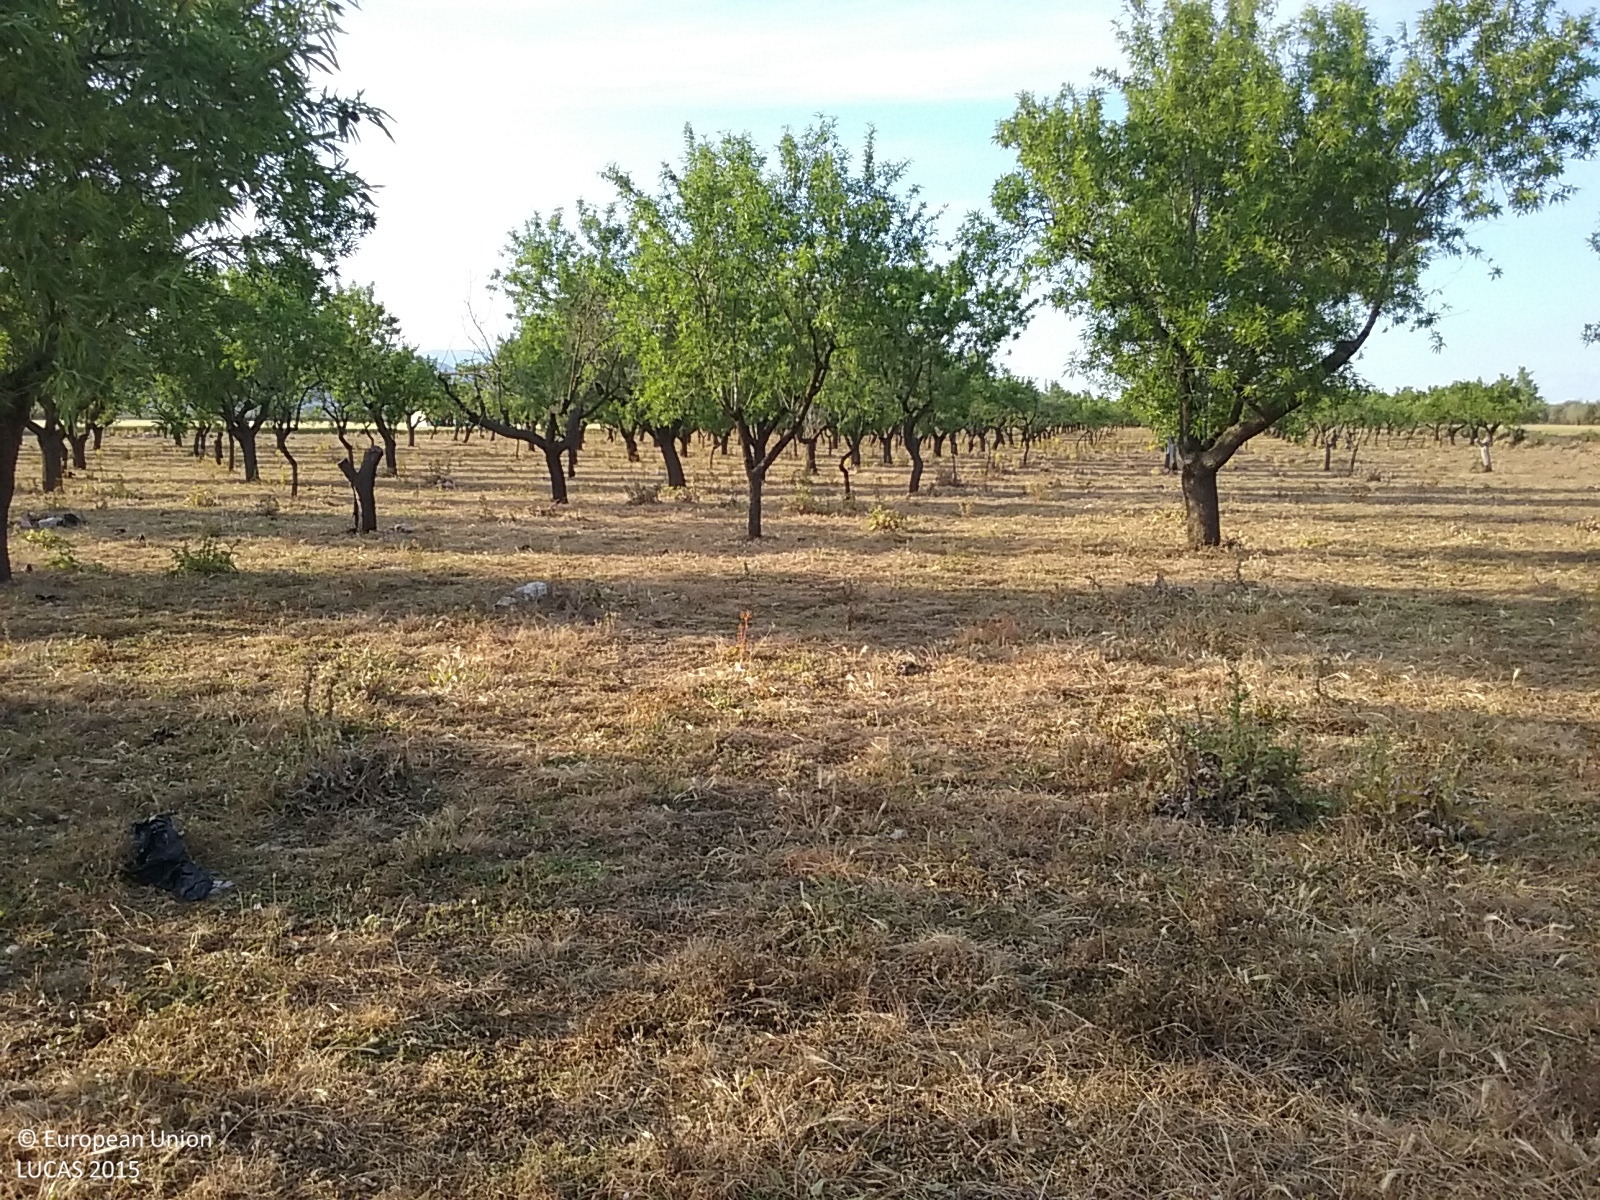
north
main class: Cropland
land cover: Nuts trees
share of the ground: 25 - 50 %
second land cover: Grassland without tree/shrub cover
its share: > 75 %
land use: Agriculture (excluding fallow land and kitchen gardens)
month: April
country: ES
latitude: 40.6313
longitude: 0.3829
